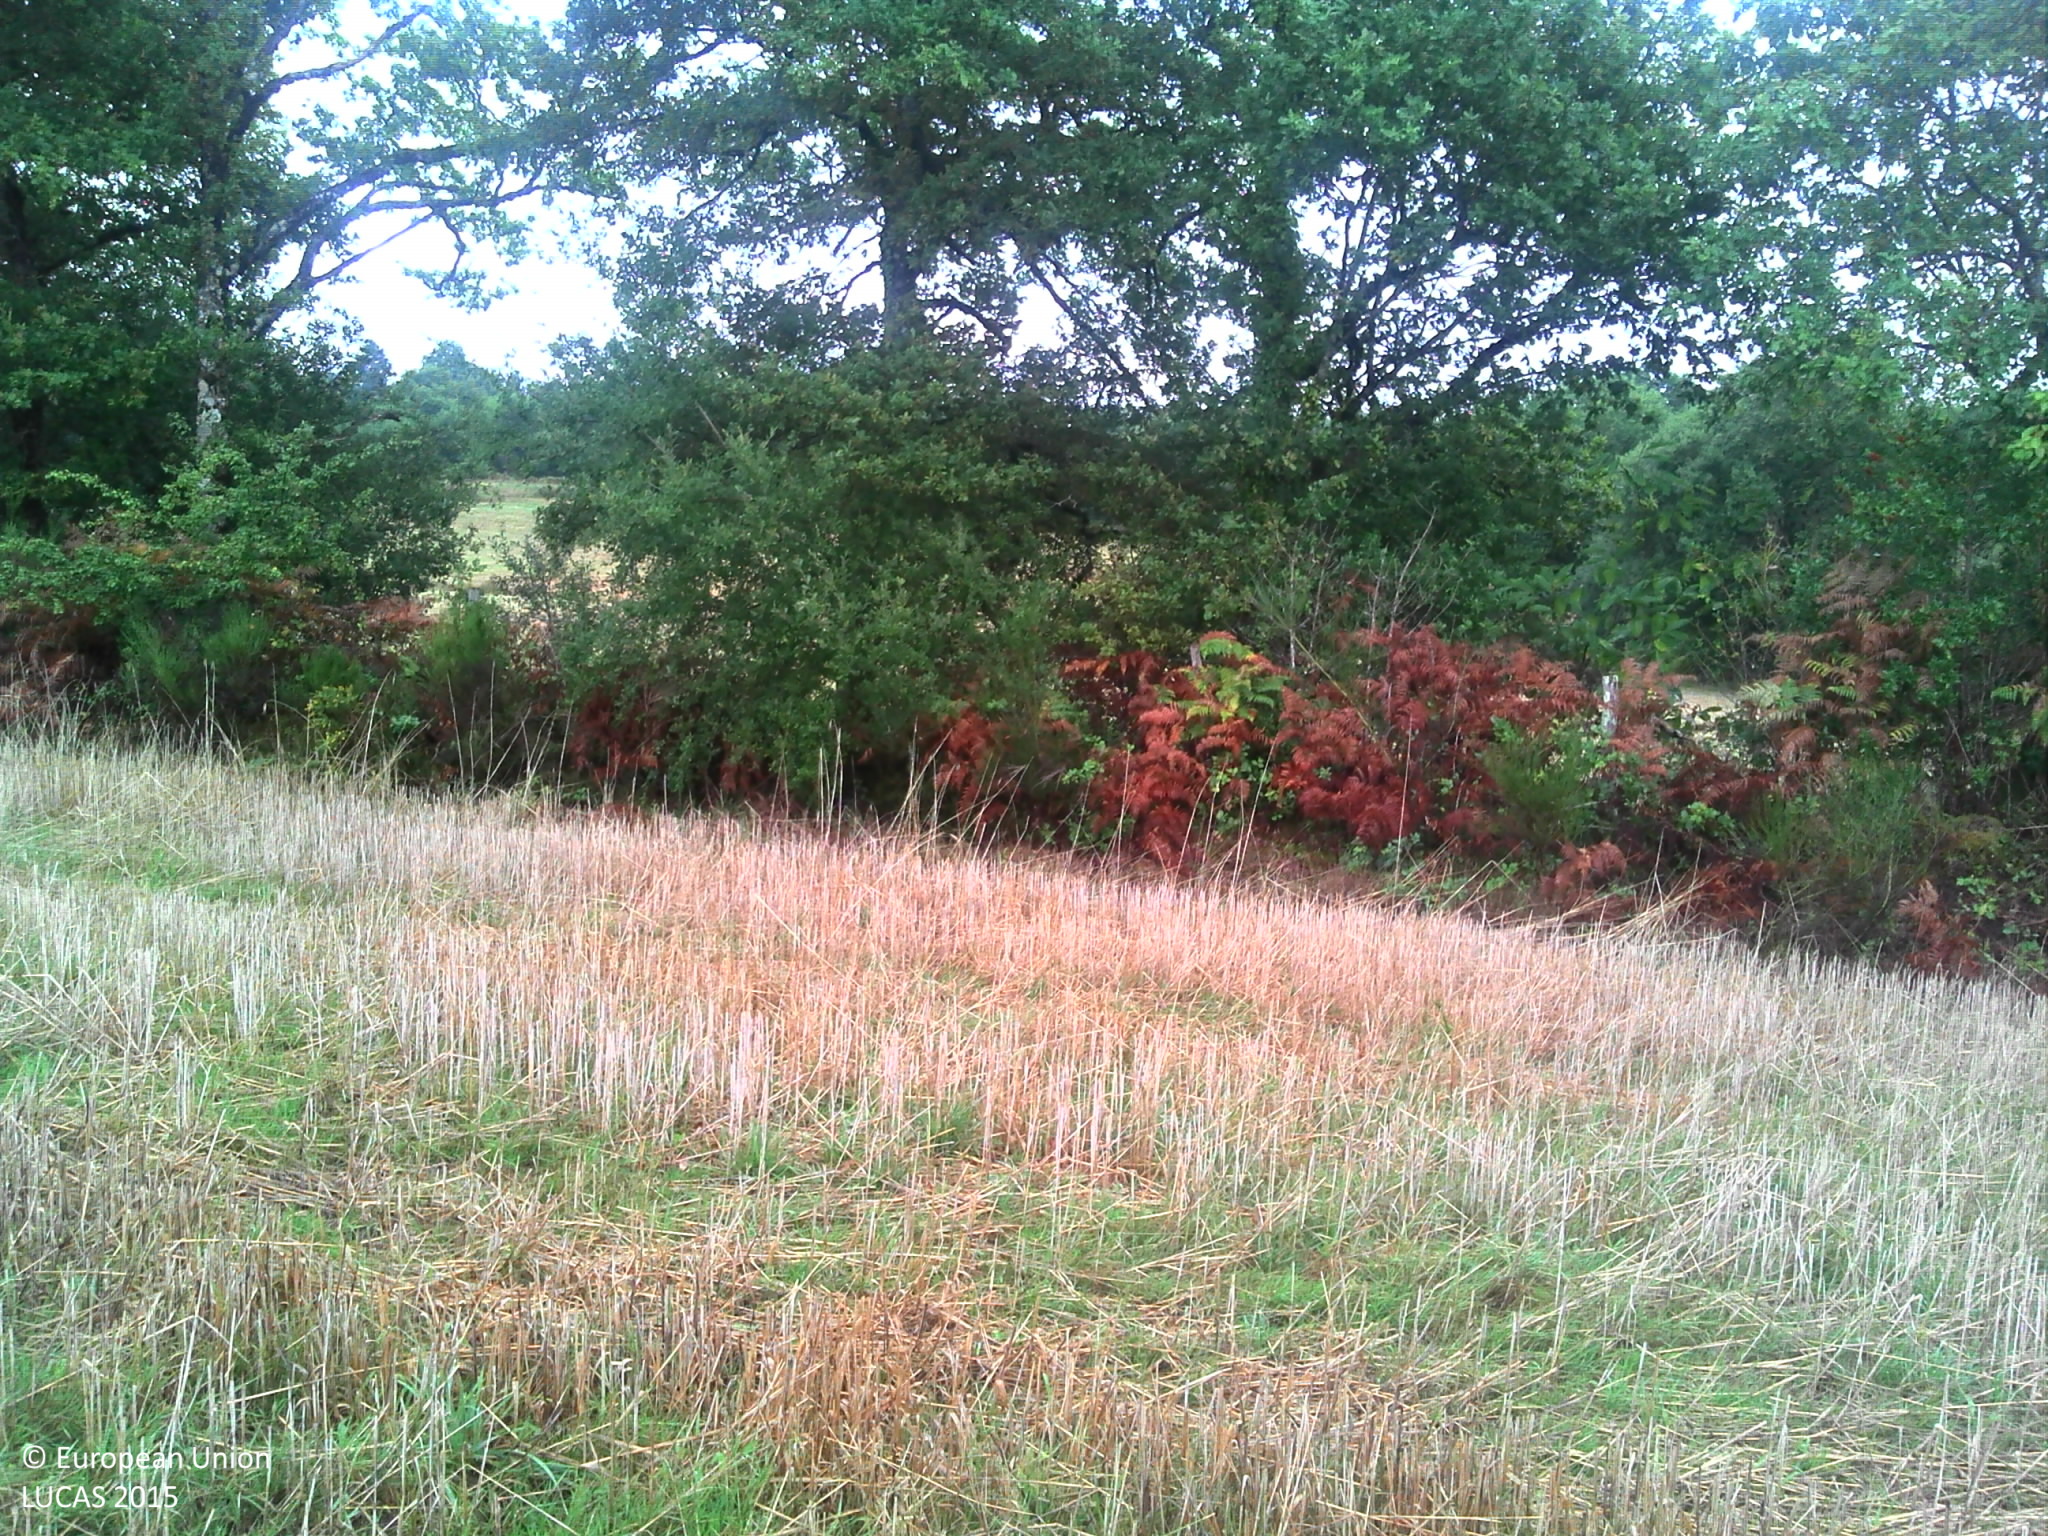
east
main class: Cropland
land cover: Barley
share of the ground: > 75 %
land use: Agriculture (excluding fallow land and kitchen gardens)
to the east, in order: Barley; Shruby margins; Fences; Shruby margins; Lines of trees; Rivers and streams; Grassland without tree/shrub cover; Rivers and streams; Grassland without tree/shrub cover; Fences; Lines of trees; Grassland without tree/shrub cover
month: August
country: FR
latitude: 46.0020
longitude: 0.9360
